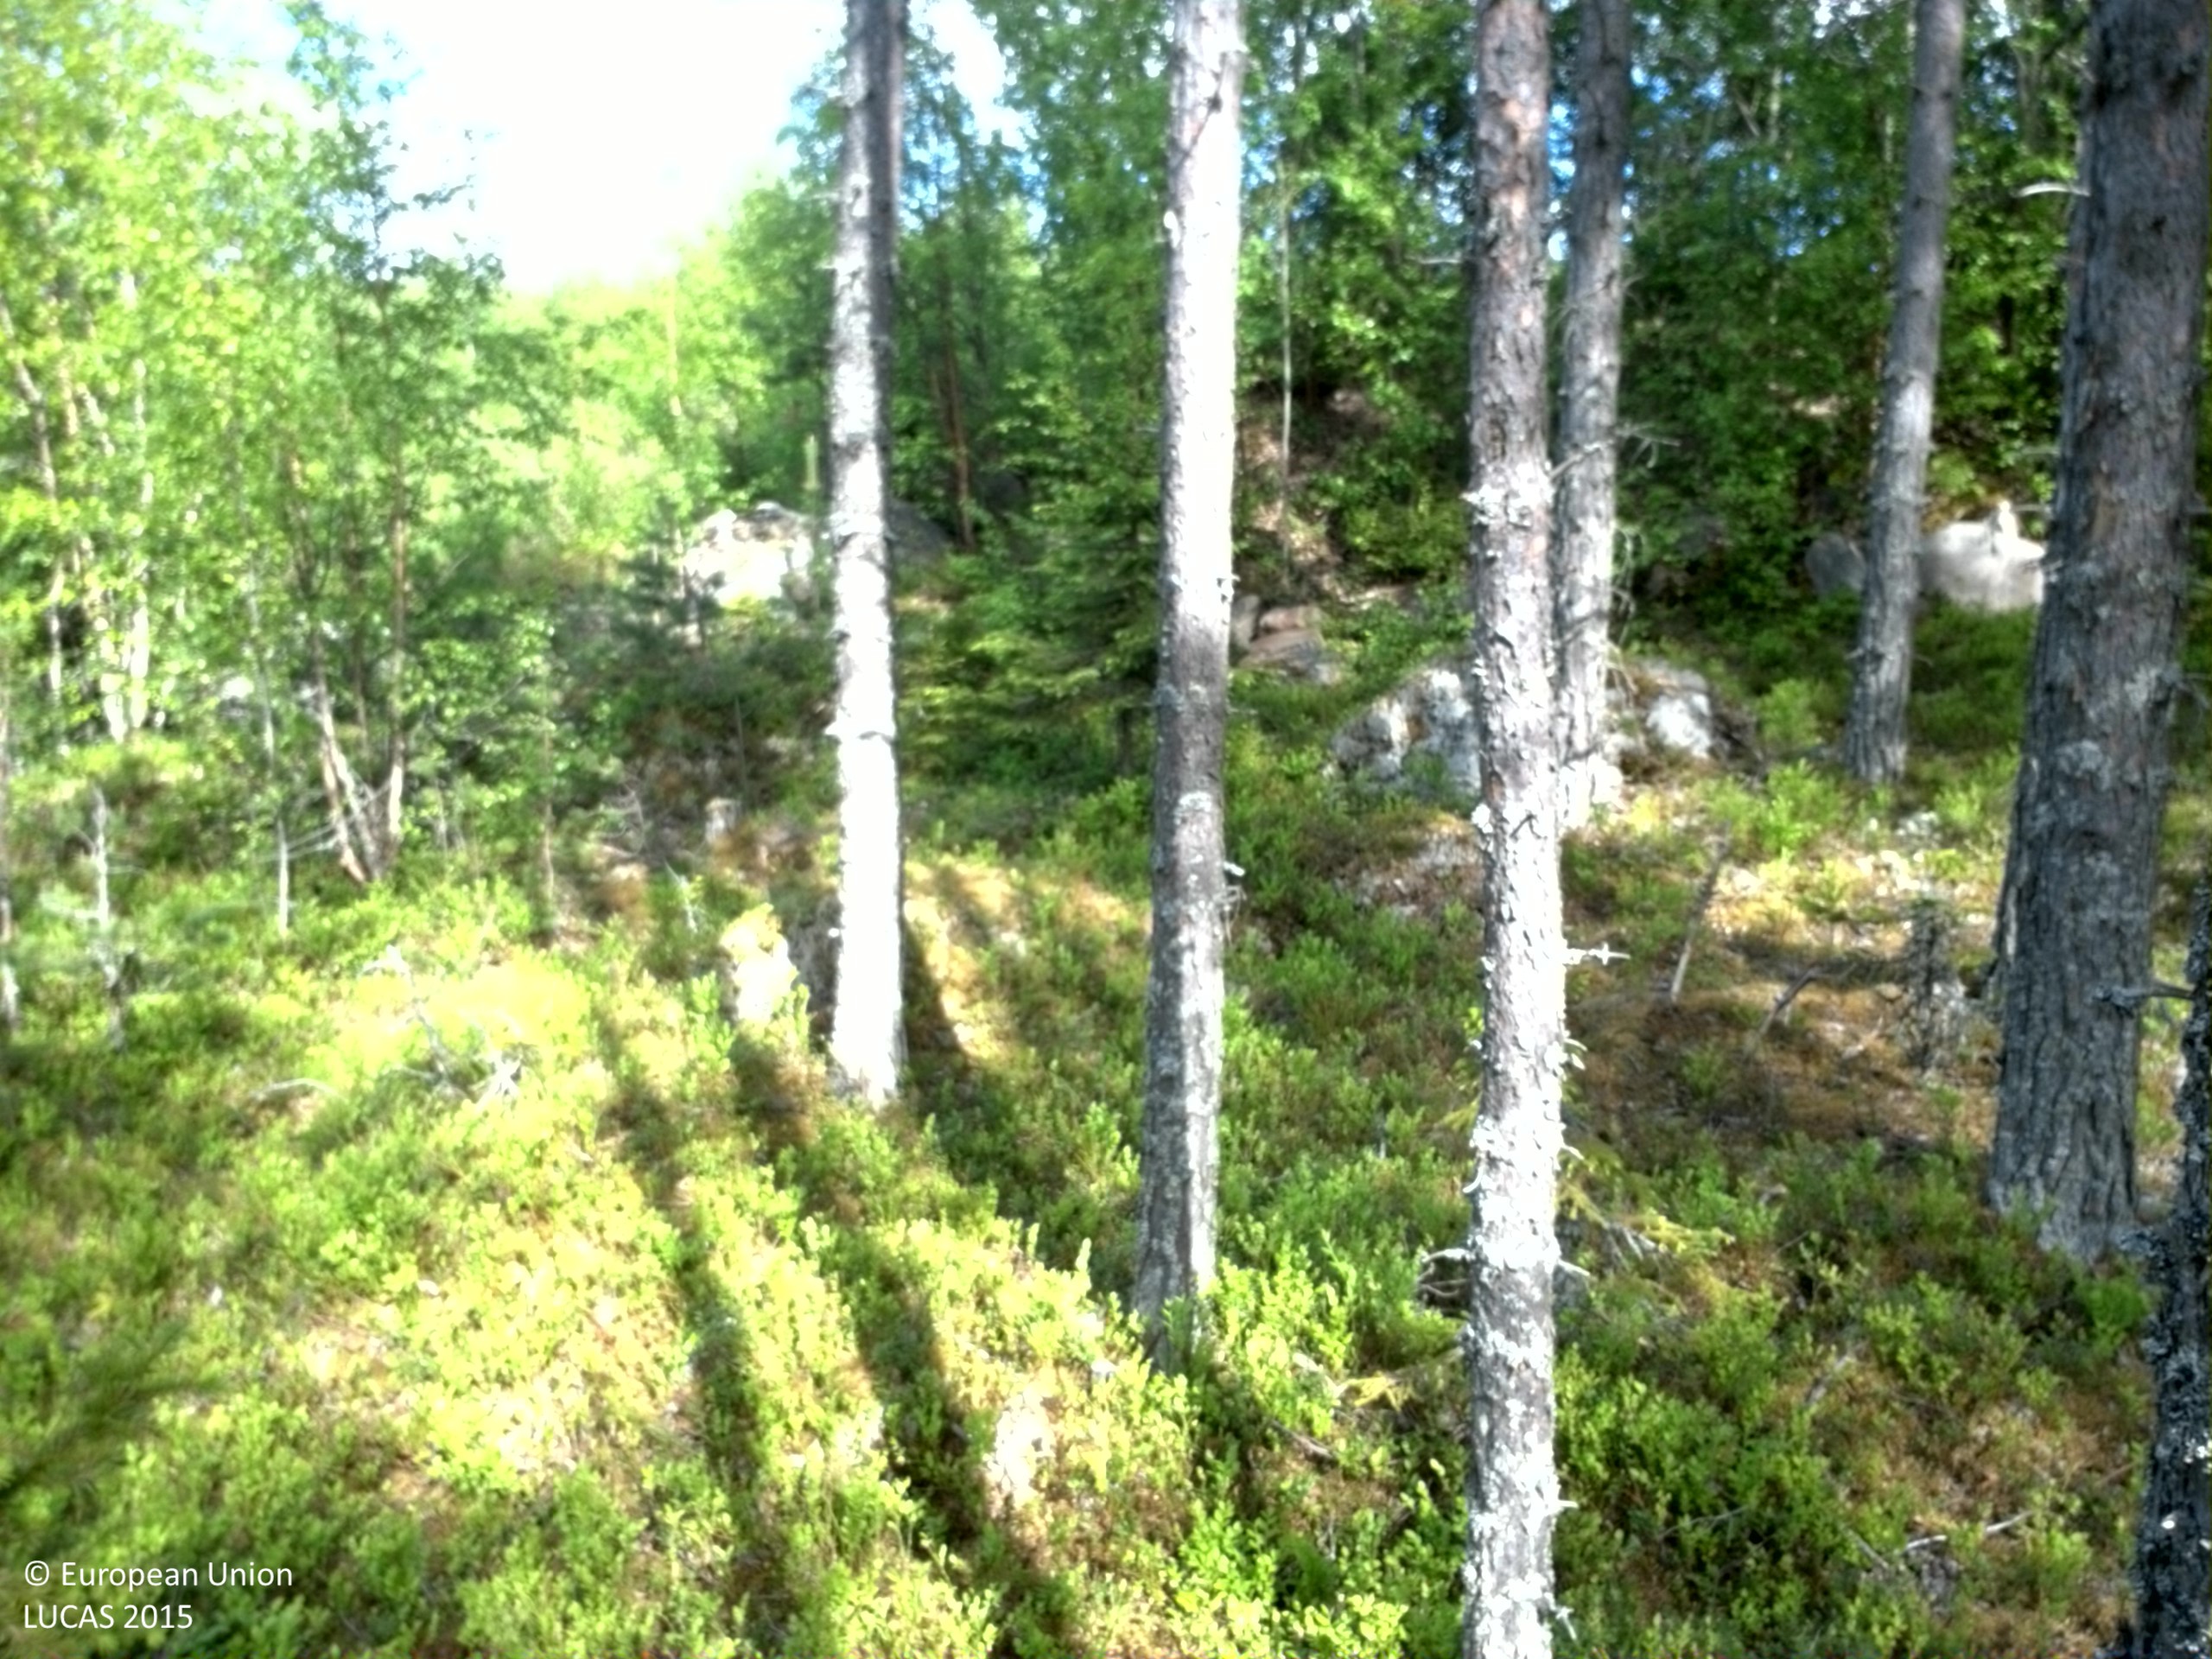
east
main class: Woodland
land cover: Pine dominated mixed woodland
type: boreal forest
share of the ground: 50 - 75 %
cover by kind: coniferous forest trees 45 %, shrubs 35 %, broadleaved forest trees 15 %, lichens and mosses 5 %
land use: Forestry
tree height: > 5 m
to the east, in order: Pine dominated mixed woodland; Other mixed woodland; Other bare soil; Paved roads, cycling and walking lanes; Pine dominated mixed woodland; Rocks and stones; Railways; Rocks and stones; Pine dominated mixed woodland; Ditches and canals; Pine dominated coniferous woodland; Paved roads, cycling and walking lanes; Ditches and canals; Spruce dominated mixed woodland
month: June
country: SE
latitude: 63.1548
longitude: 17.7772
